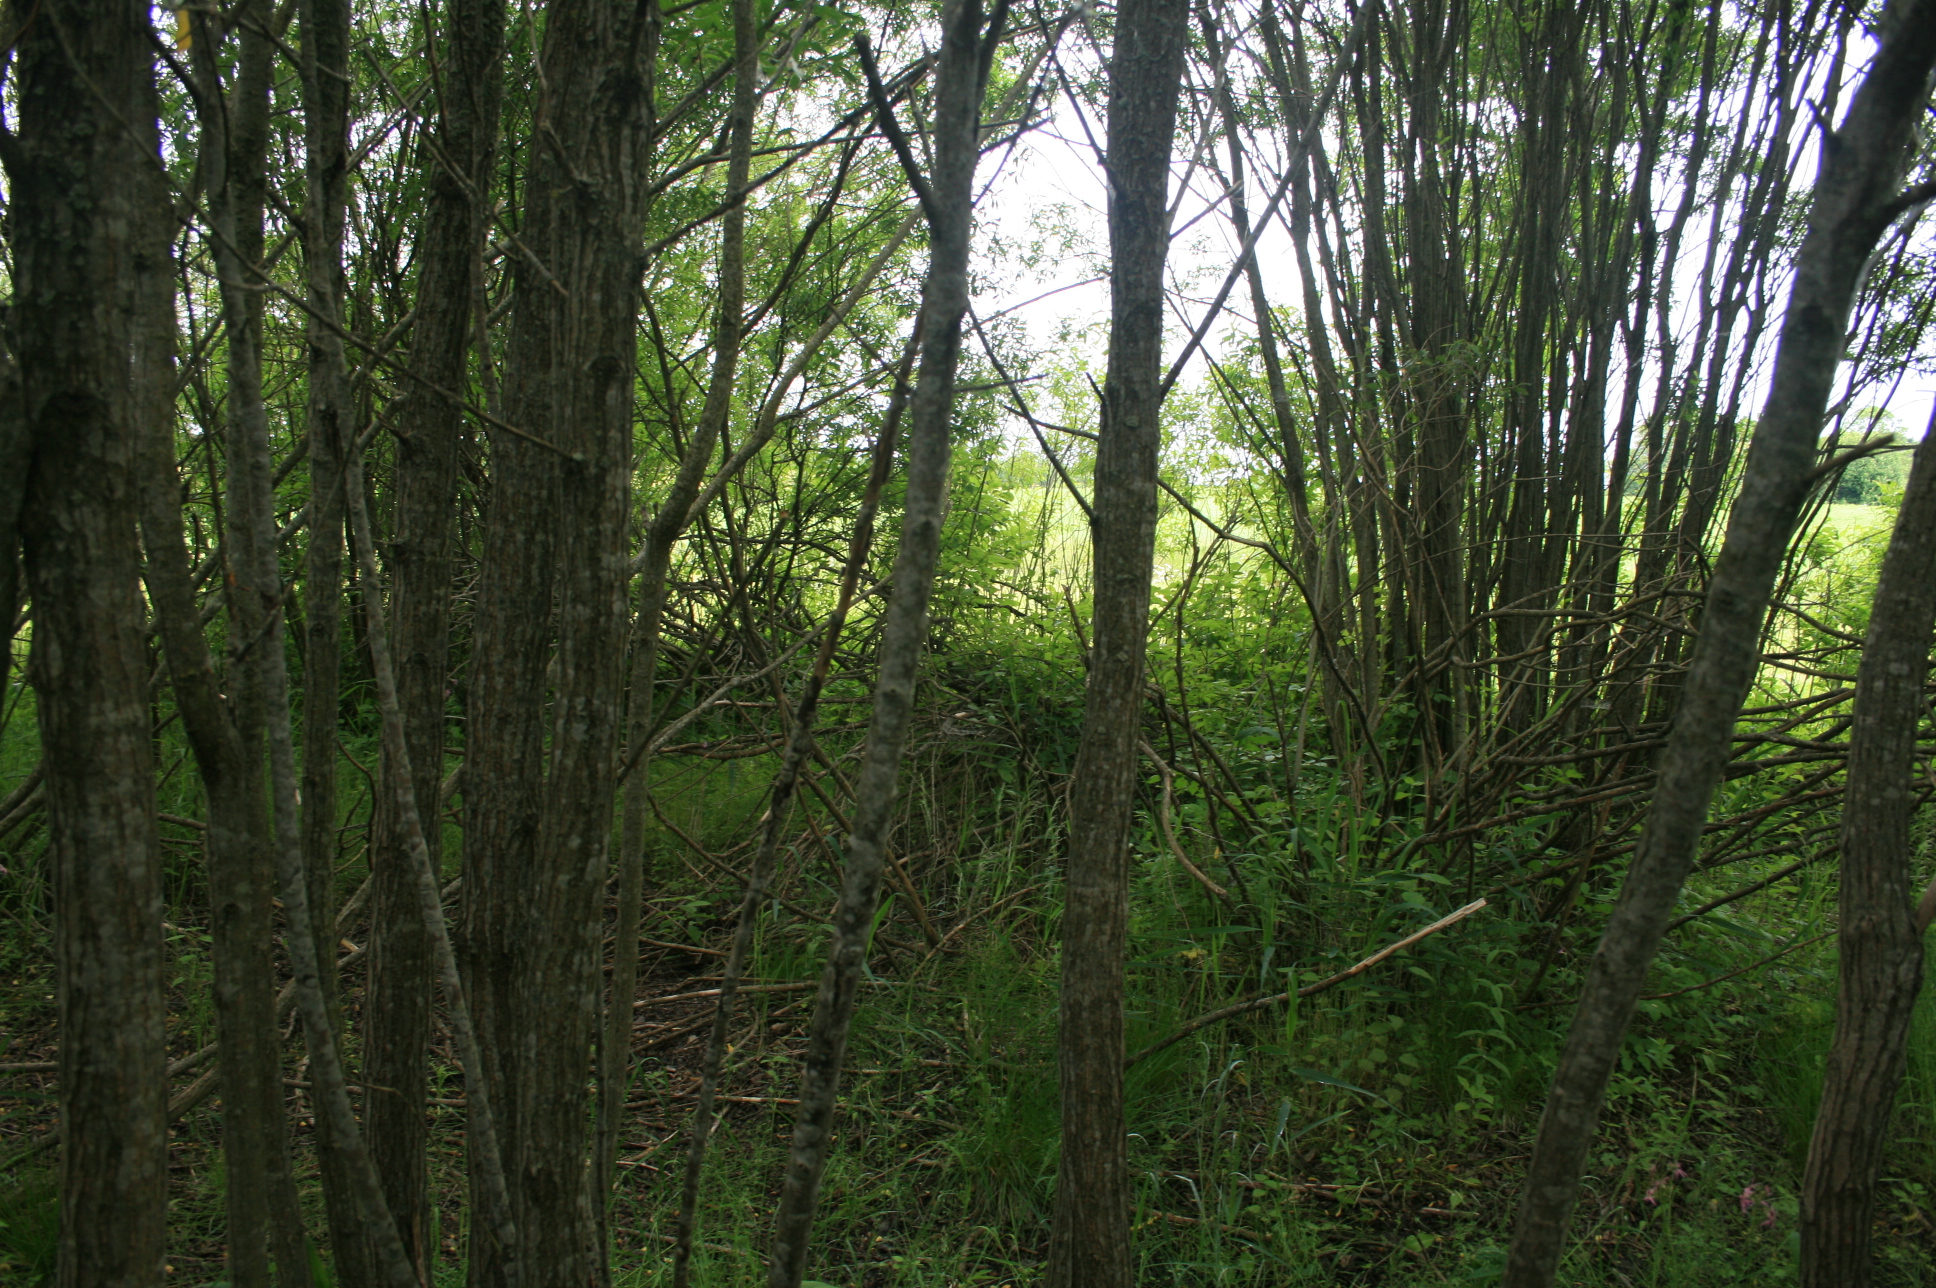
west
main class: Woodland
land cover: Broadleaved woodland
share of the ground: > 75 %
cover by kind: broadleaved forest trees 85 %, herbaceous plants 10 %, shrubs 5 %
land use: Semi-natural and natural areas not in use
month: June
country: LT
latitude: 55.6762
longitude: 22.3824
